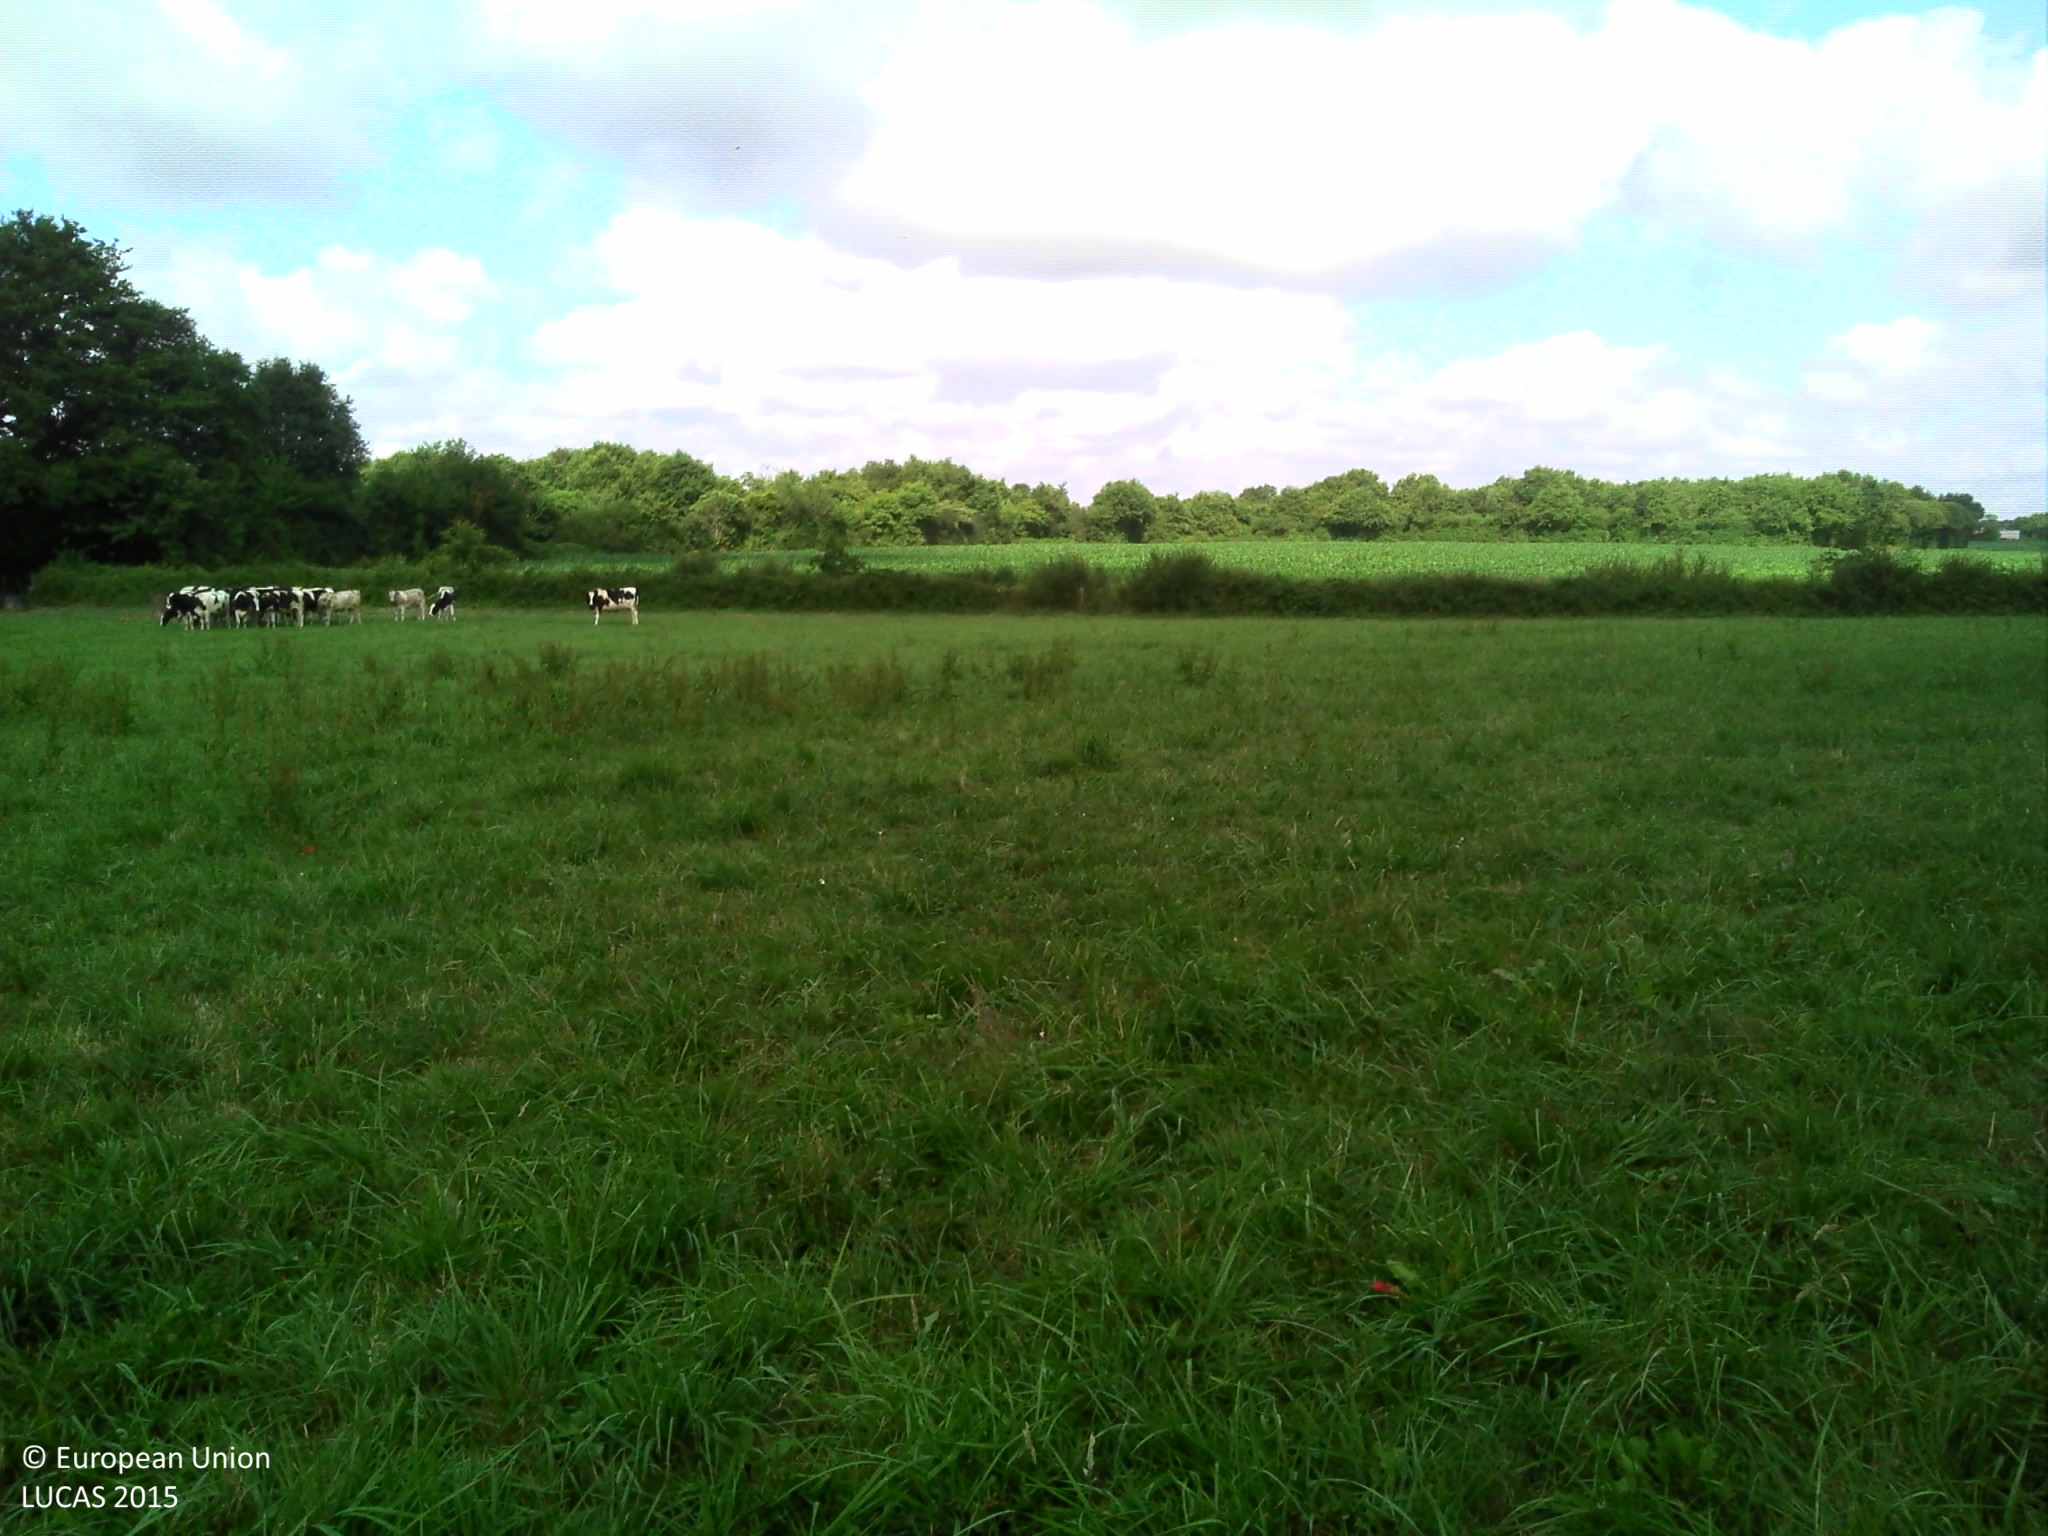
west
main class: Cropland
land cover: Temporary grasslands
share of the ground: > 75 %
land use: Agriculture (excluding fallow land and kitchen gardens)
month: July
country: FR
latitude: 47.3748
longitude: -1.5786
